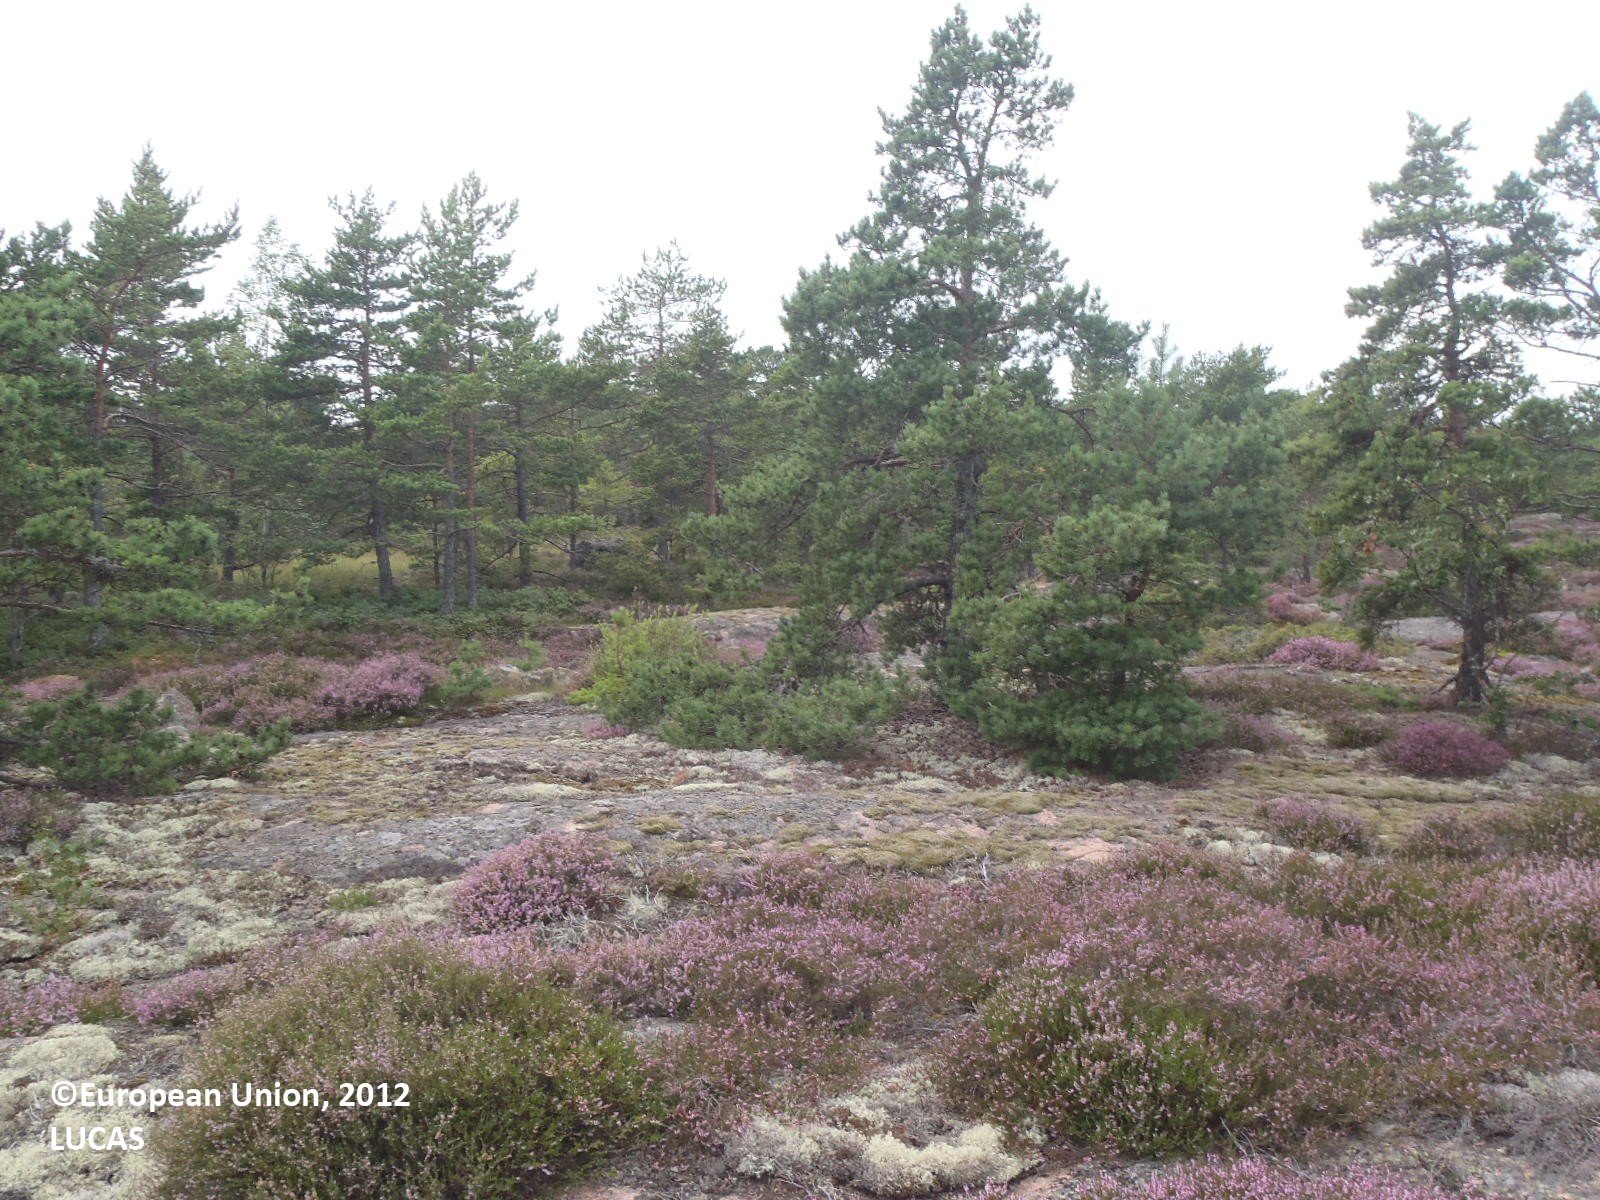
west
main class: Woodland
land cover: Pine dominated coniferous woodland
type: boreal forest
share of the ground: 10 - 25 %
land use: Semi-natural and natural areas not in use
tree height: > 5 m
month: August
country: FI
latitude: 60.2321
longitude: 20.3928
